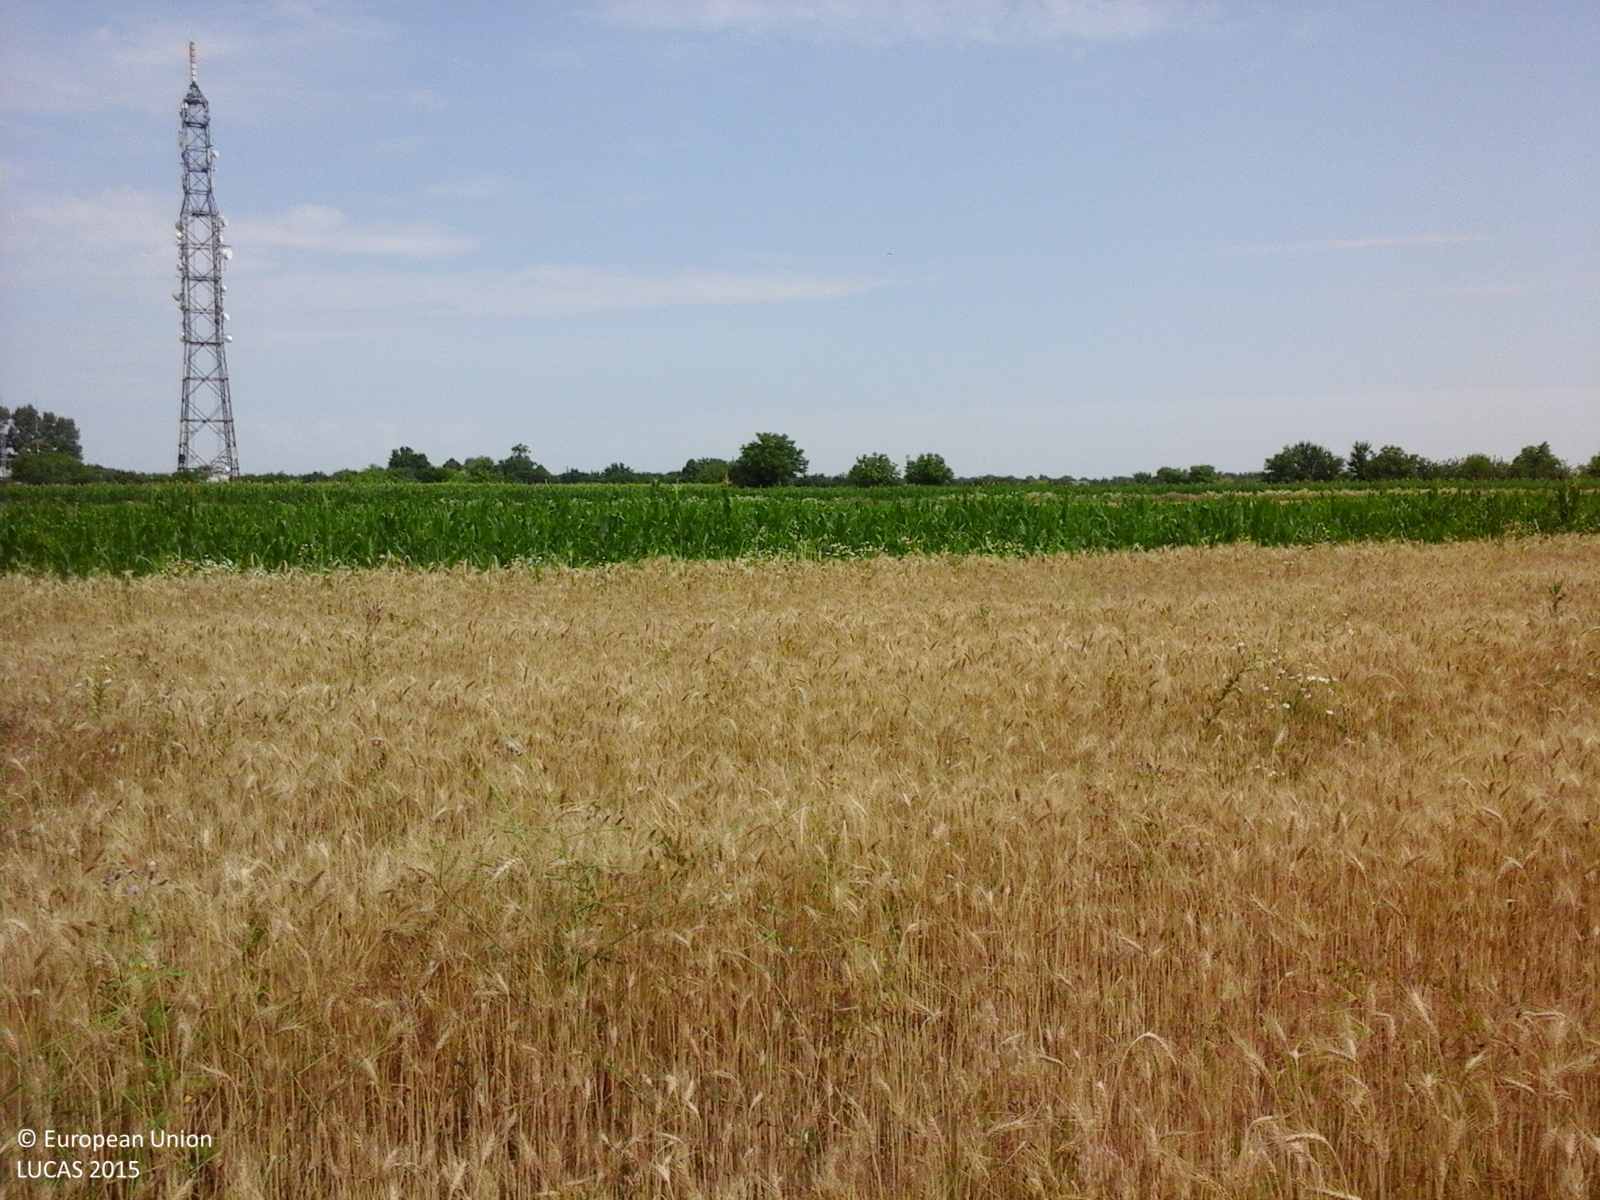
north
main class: Cropland
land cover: Common wheat
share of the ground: > 75 %
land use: Agriculture (excluding fallow land and kitchen gardens)
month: June
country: RO
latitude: 44.1595
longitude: 26.3772
